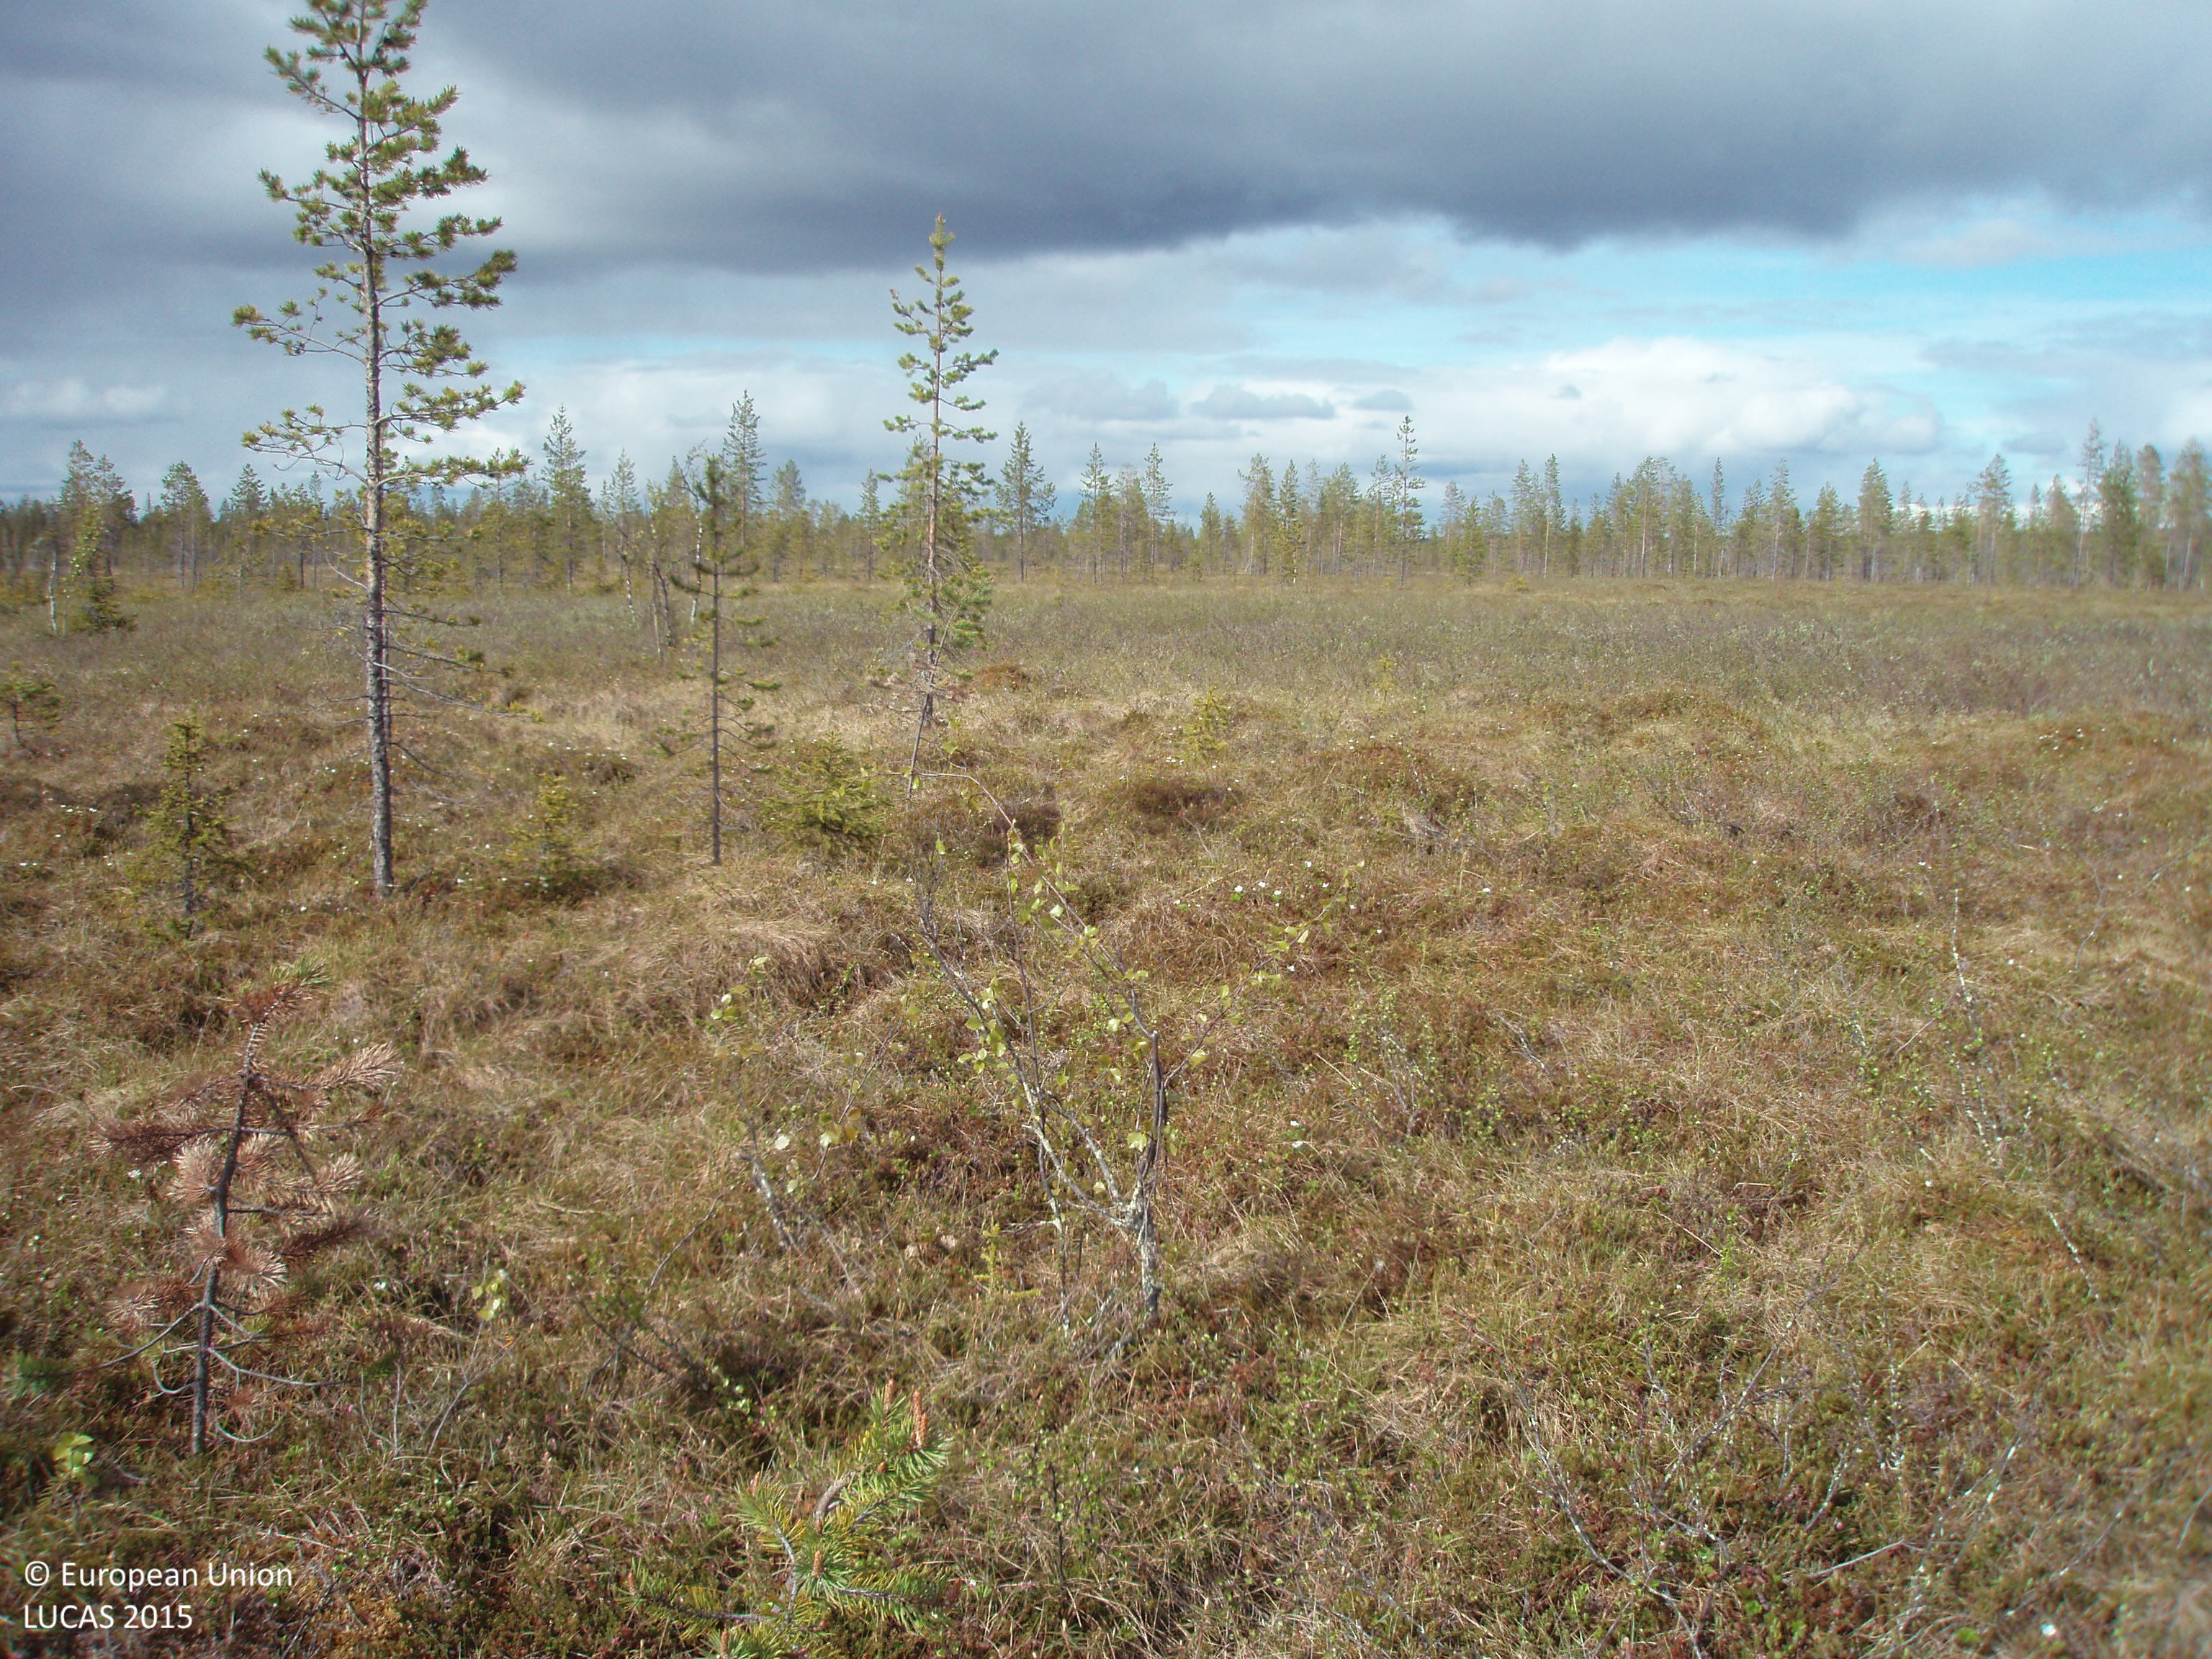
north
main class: Woodland
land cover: Pine dominated coniferous woodland
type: mire and swamp forests
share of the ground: 10 - 25 %
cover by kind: shrubs 50 %, lichens and mosses 20 %, coniferous forest trees 15 %, herbaceous plants 10 %, broadleaved forest trees 5 %
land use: Semi-natural and natural areas not in use
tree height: > 5 m
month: June
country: FI
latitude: 67.9756
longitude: 26.8222
